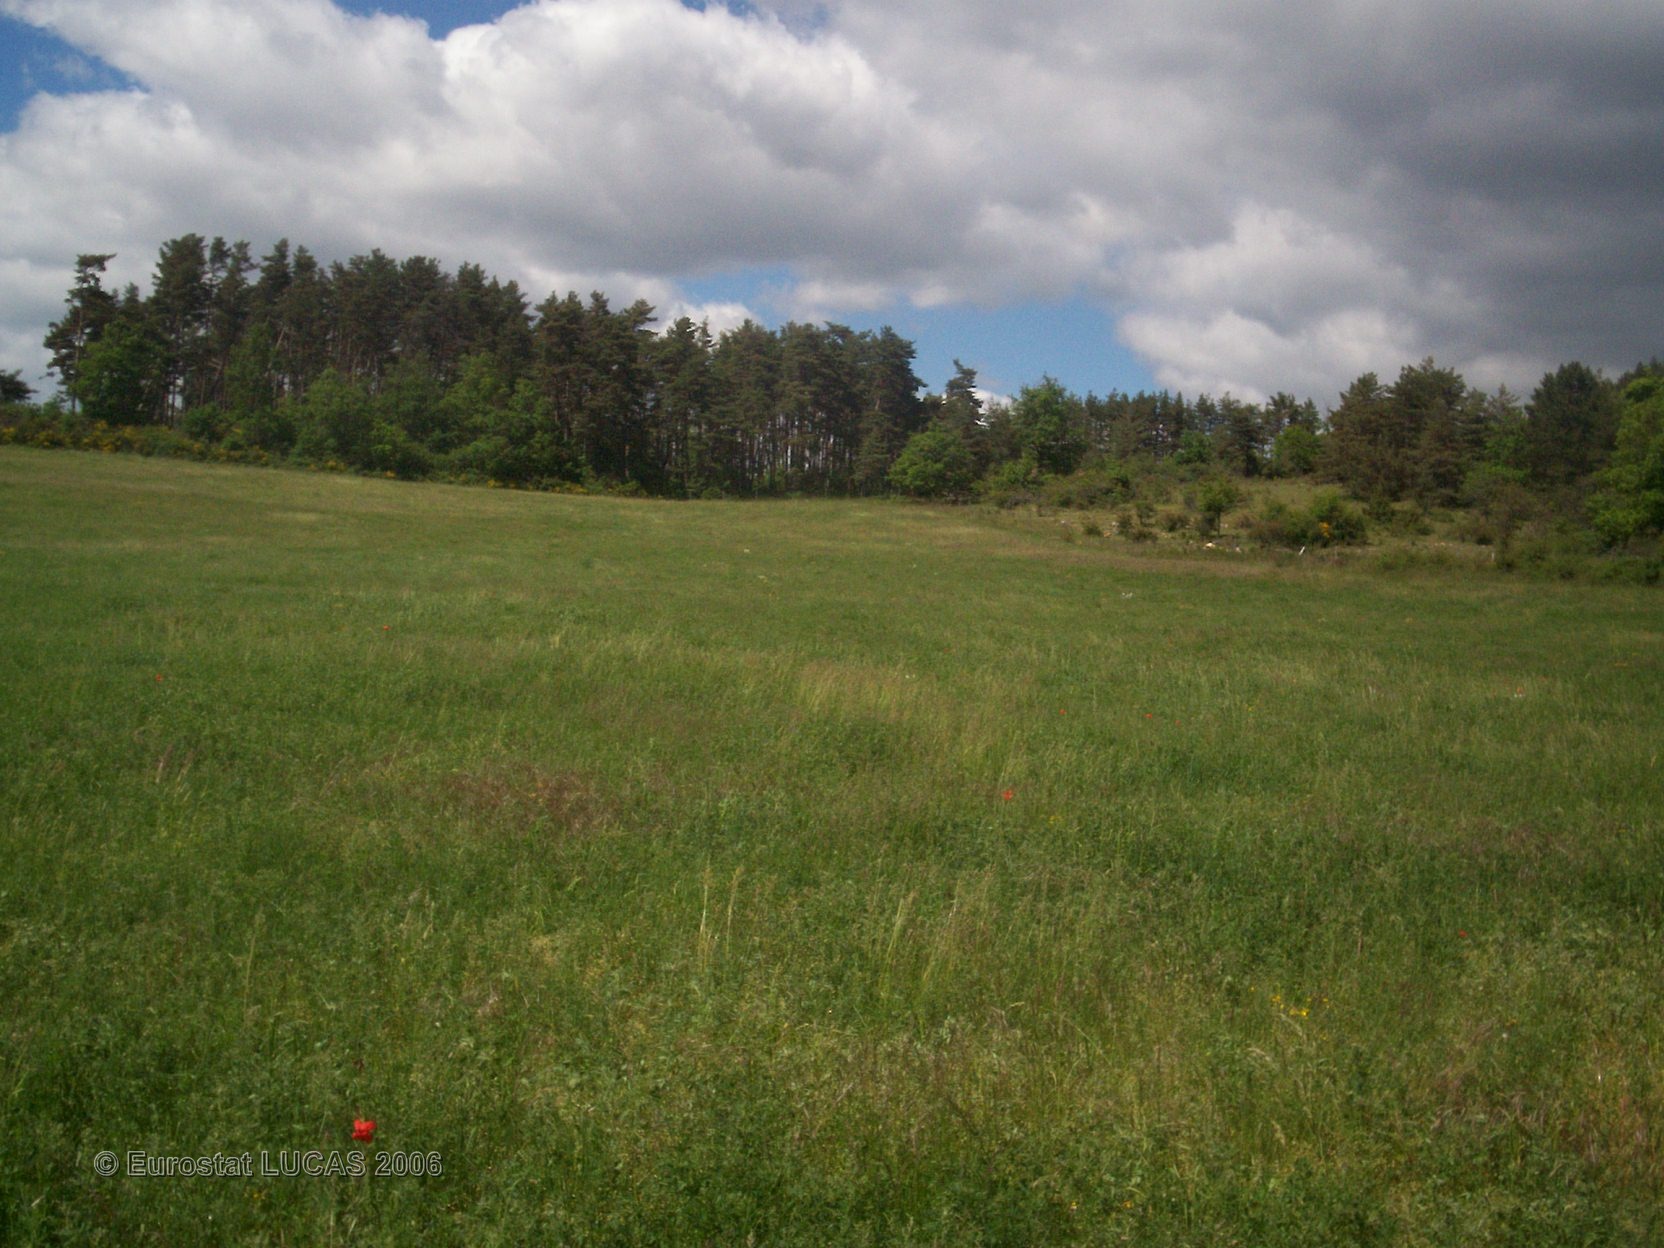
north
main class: Grassland
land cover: Grassland without tree/shrub cover
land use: Agriculture (excluding fallow land and kitchen gardens)
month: June
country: FR
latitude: 44.4975
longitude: 3.3268
